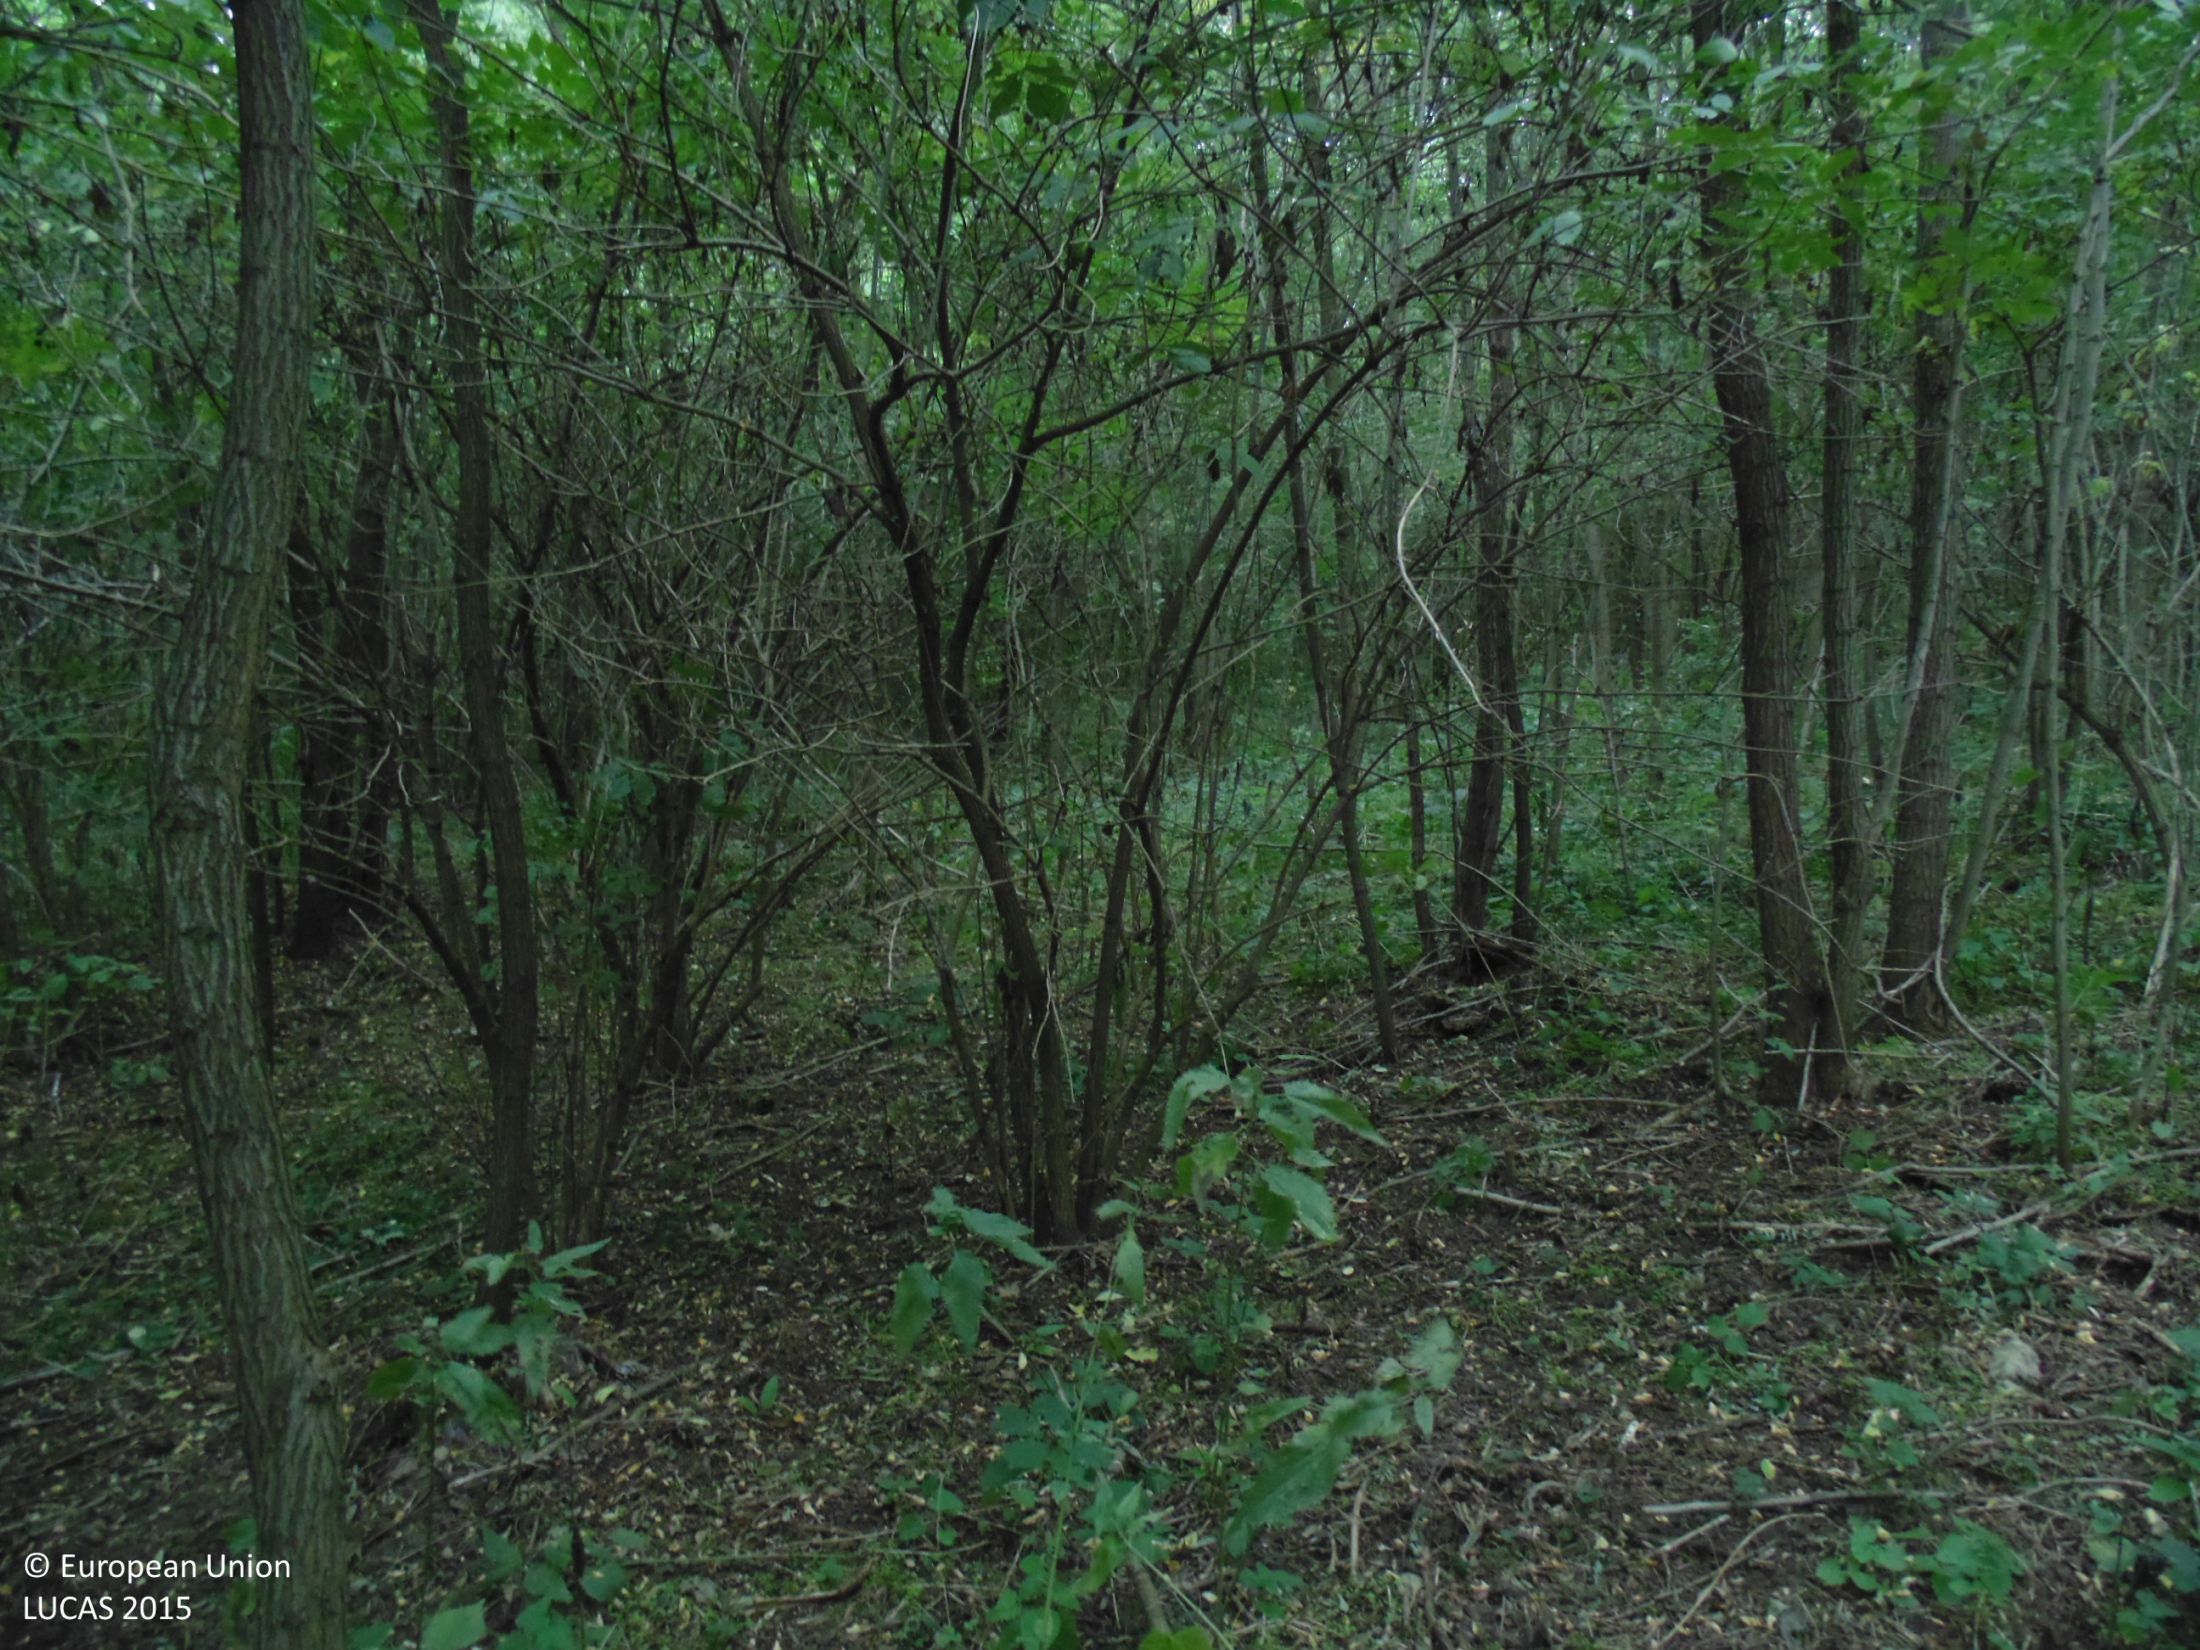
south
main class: Woodland
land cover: Broadleaved woodland
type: mesophytic deciduous forest
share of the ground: > 75 %
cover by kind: broadleaved forest trees 90 %, shrubs 5 %, unconsolidated bare surface 5 %
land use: Forestry
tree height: > 5 m
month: September
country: BG
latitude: 44.0245
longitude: 26.9781
